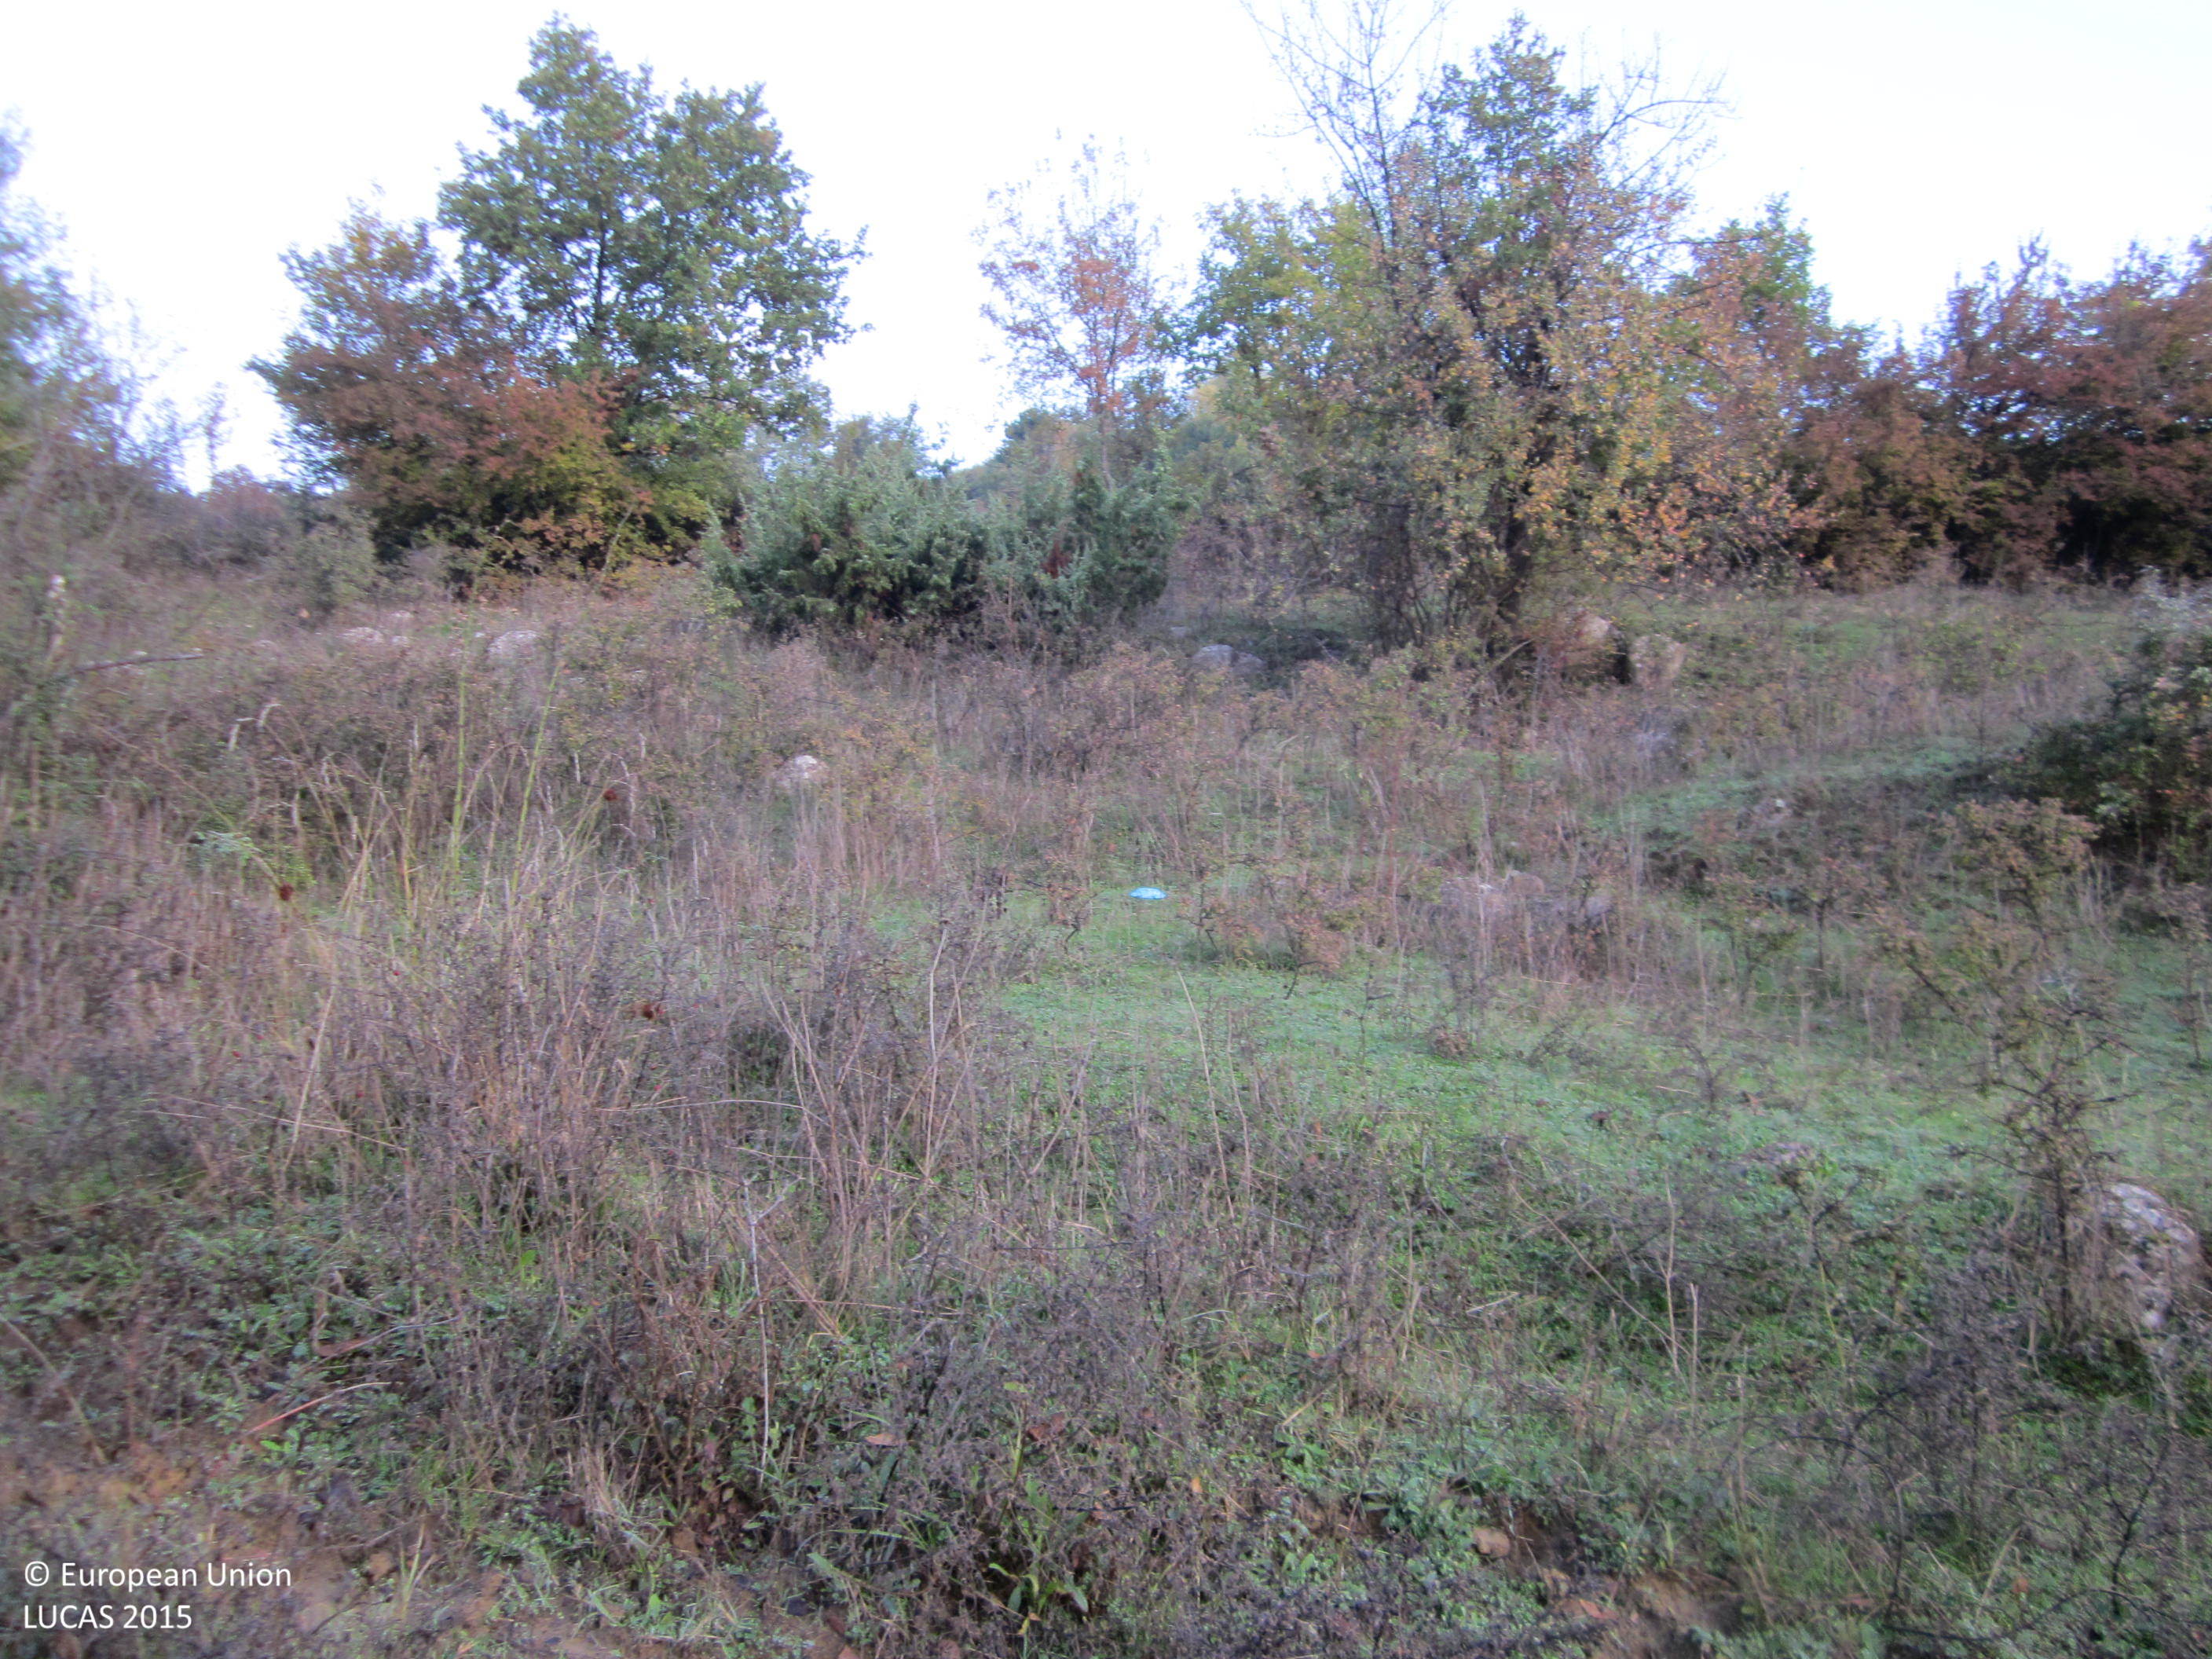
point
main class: Shrubland
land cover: Shrubland with sparse tree cover
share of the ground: 50 - 75 %
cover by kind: shrubs 55 %, herbaceous plants 30 %, unconsolidated bare surface 10 %, broadleaved forest trees 5 %
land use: Agriculture (excluding fallow land and kitchen gardens)
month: October
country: BG
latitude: 41.3838
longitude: 25.4694
